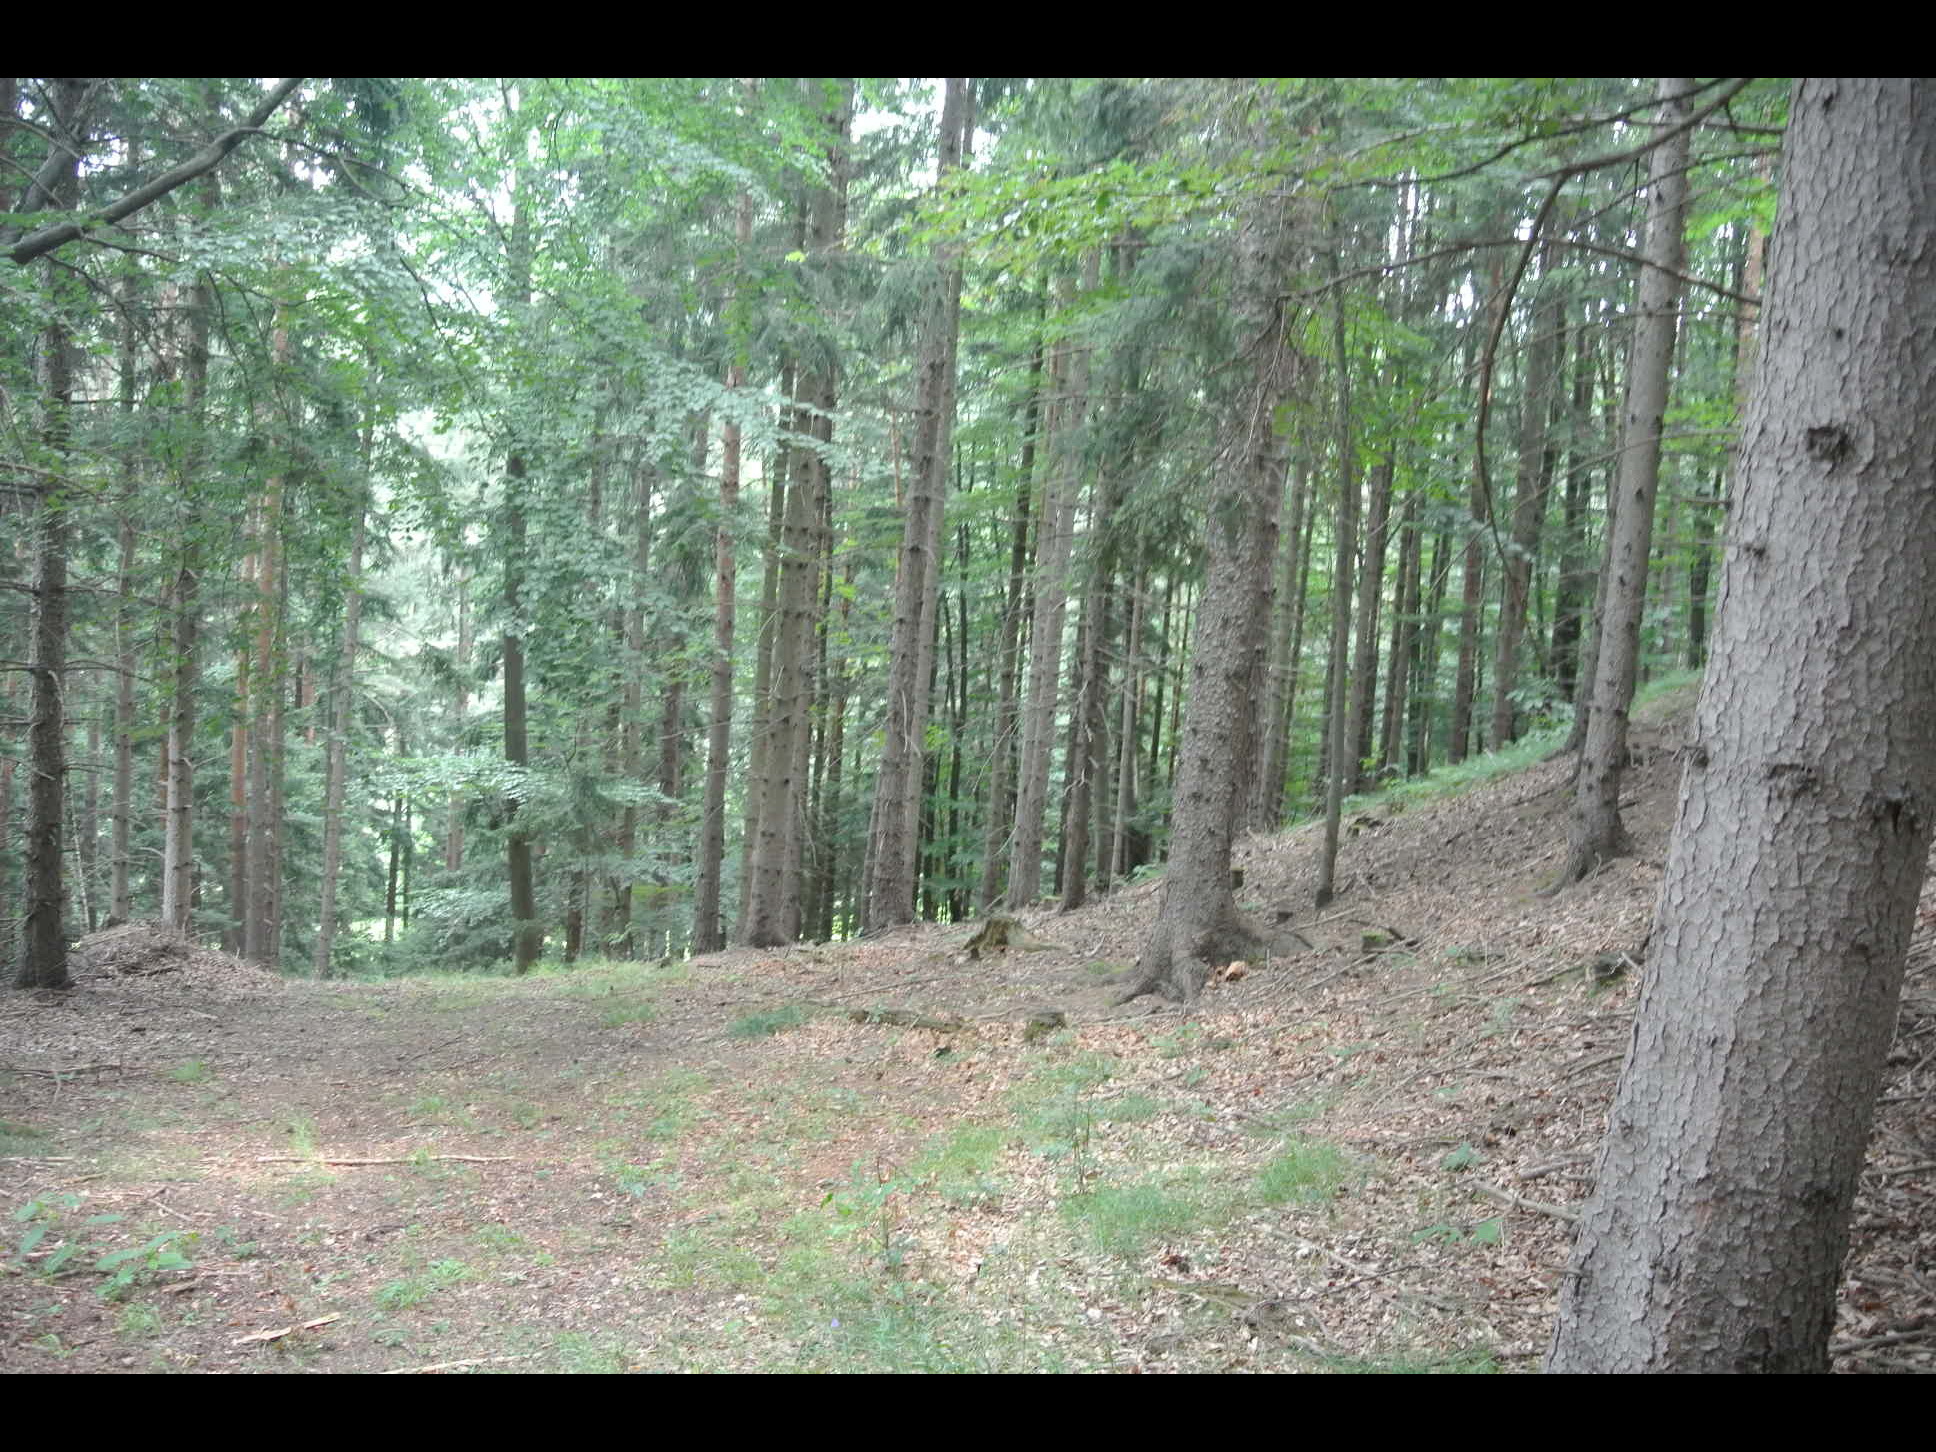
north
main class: Woodland
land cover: Other mixed woodland
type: alpine coniferous forest
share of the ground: > 75 %
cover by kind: coniferous forest trees 60 %, broadleaved forest trees 40 %
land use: Forestry
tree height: > 5 m
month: July
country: AT
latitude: 47.6732
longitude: 16.1431
